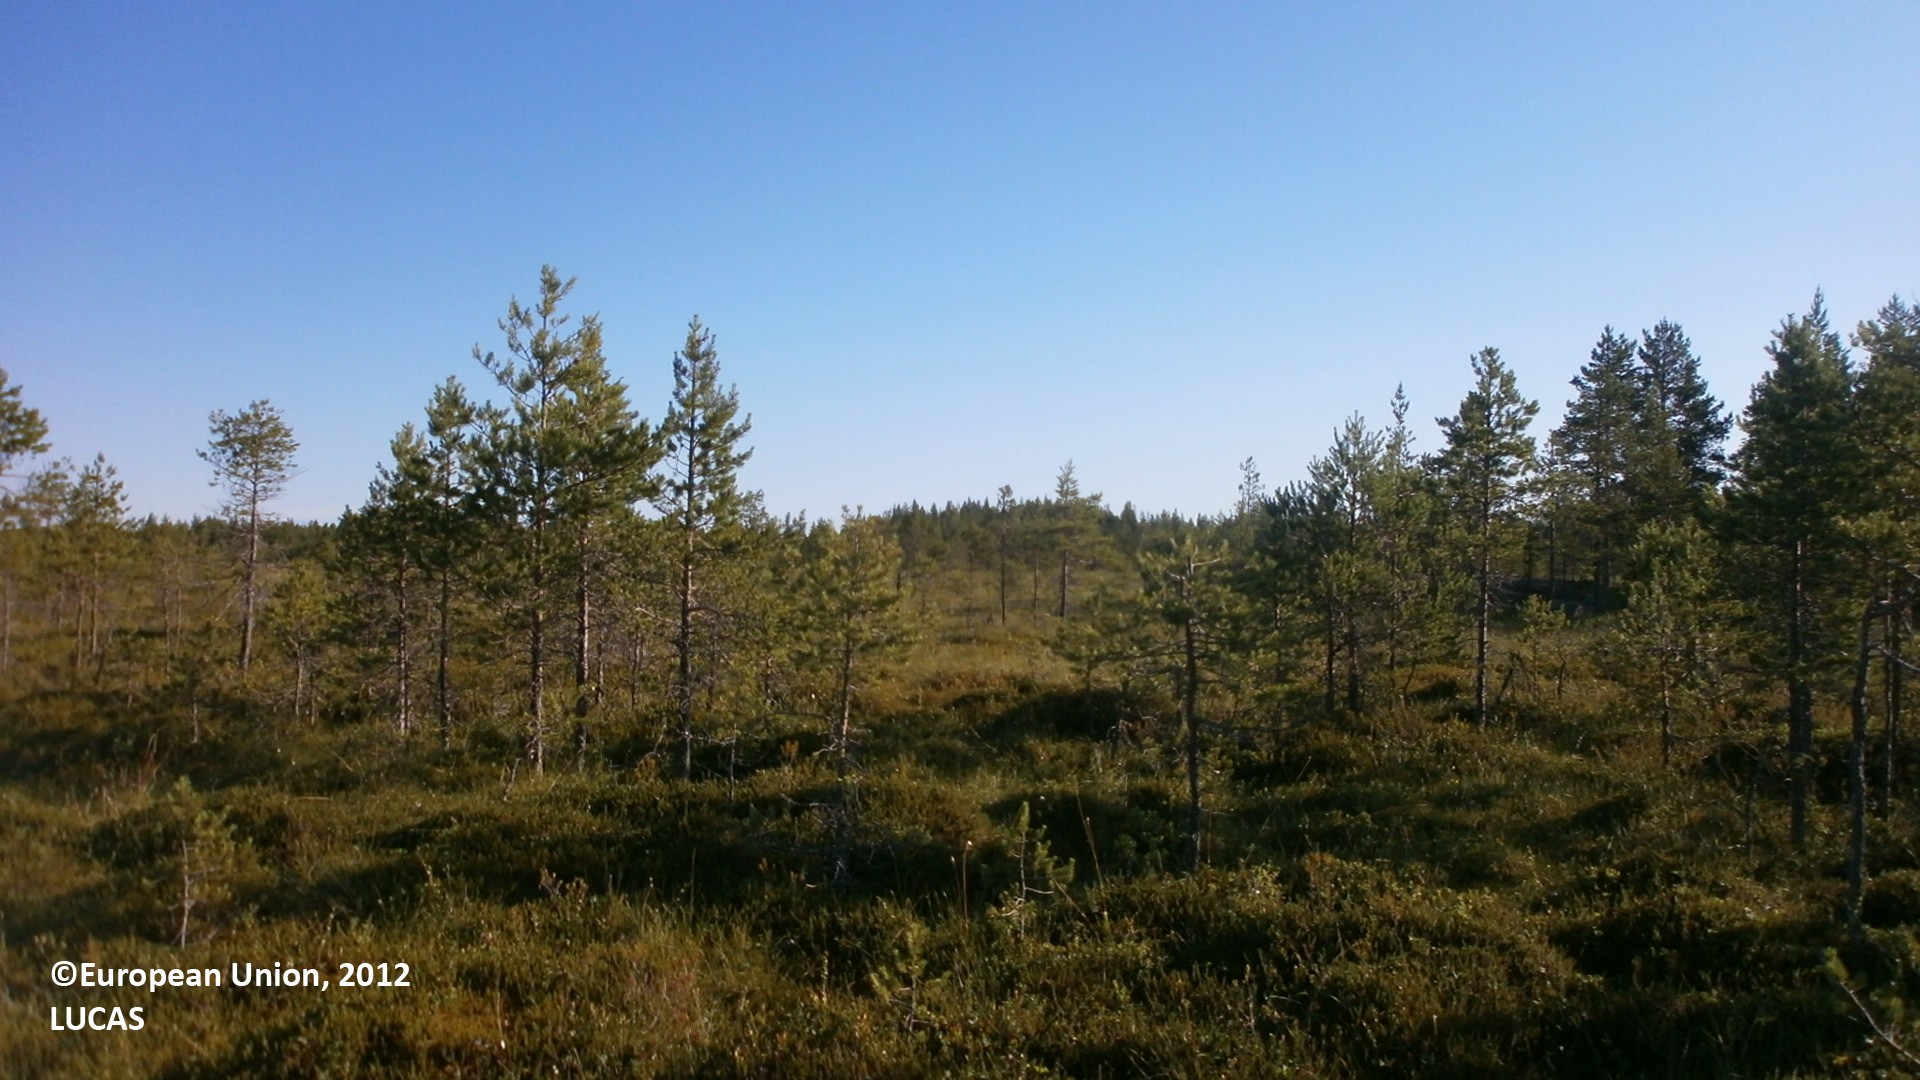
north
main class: Woodland
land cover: Pine dominated coniferous woodland
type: boreal forest
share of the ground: 10 - 25 %
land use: Semi-natural and natural areas not in use
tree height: < 5 m
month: July
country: FI
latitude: 64.0200
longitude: 24.1237
